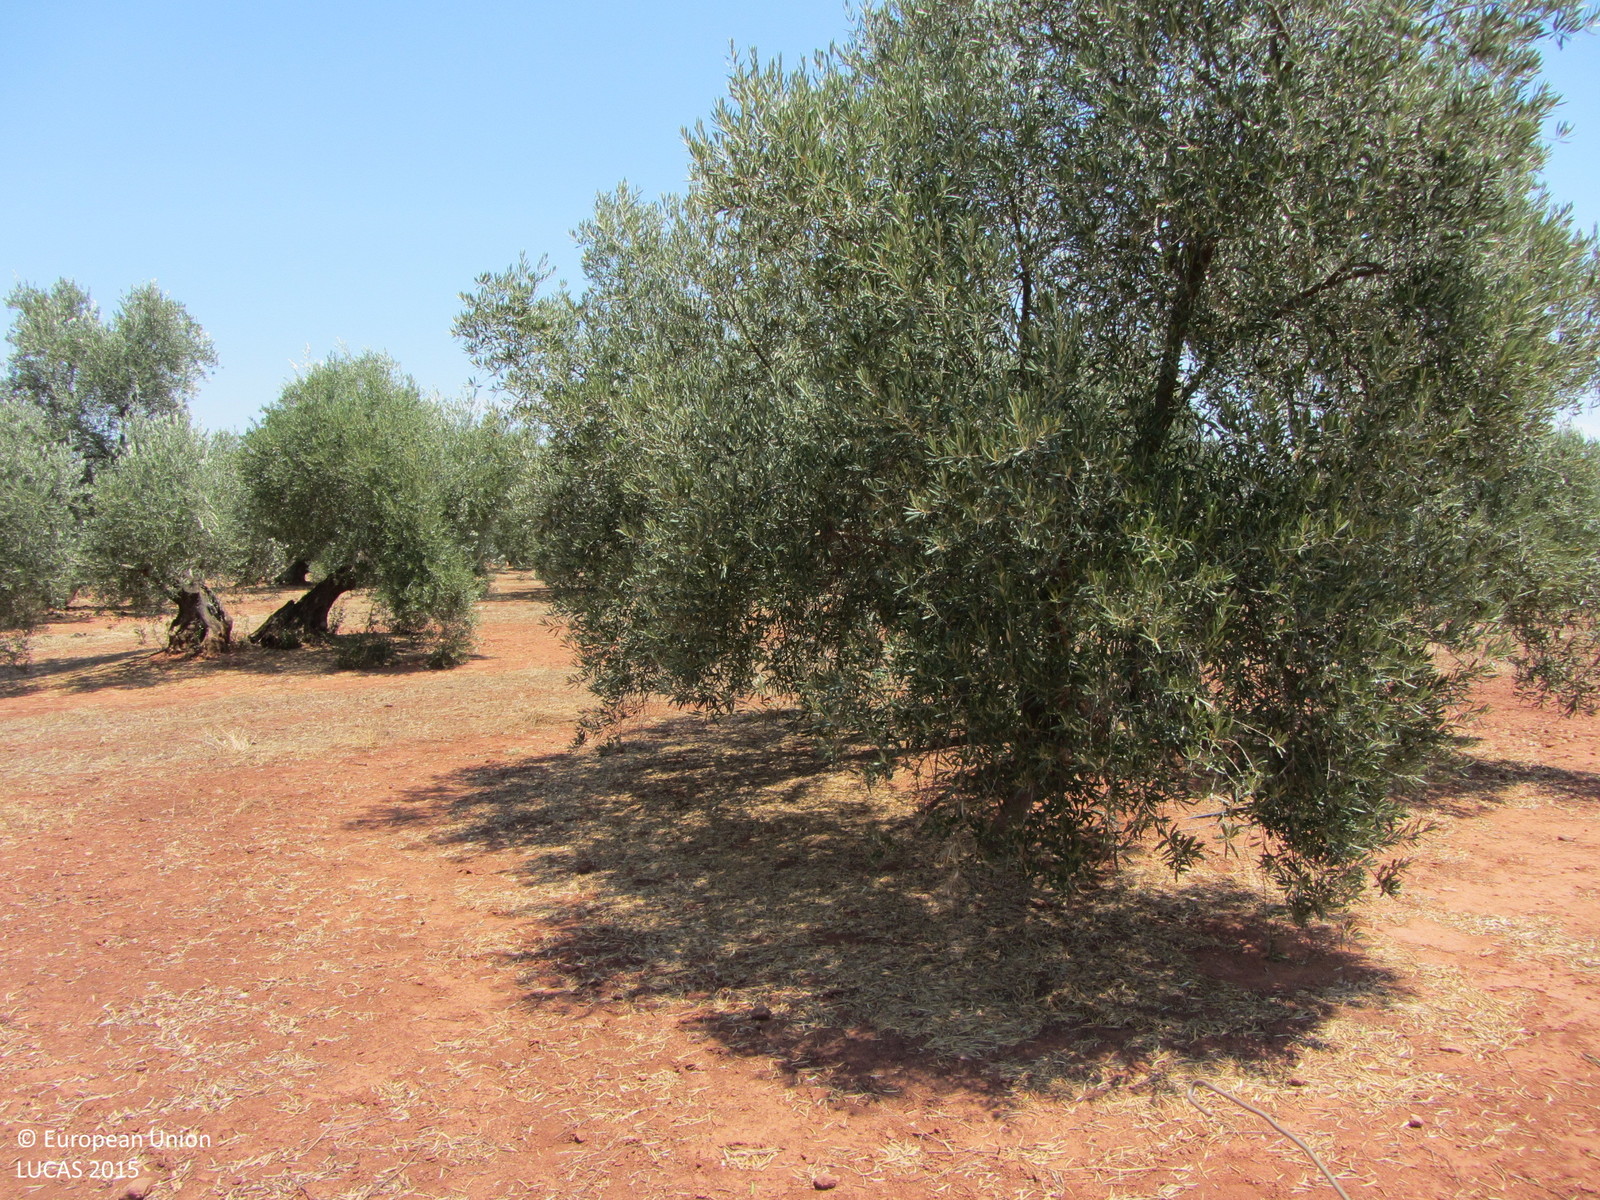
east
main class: Cropland
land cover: Olive groves
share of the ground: 25 - 50 %
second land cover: Other bare soil
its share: > 75 %
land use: Agriculture (excluding fallow land and kitchen gardens)
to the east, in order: Olive groves; Other bare soil; Olive groves
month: June
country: ES
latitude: 38.2011
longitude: -3.4440
